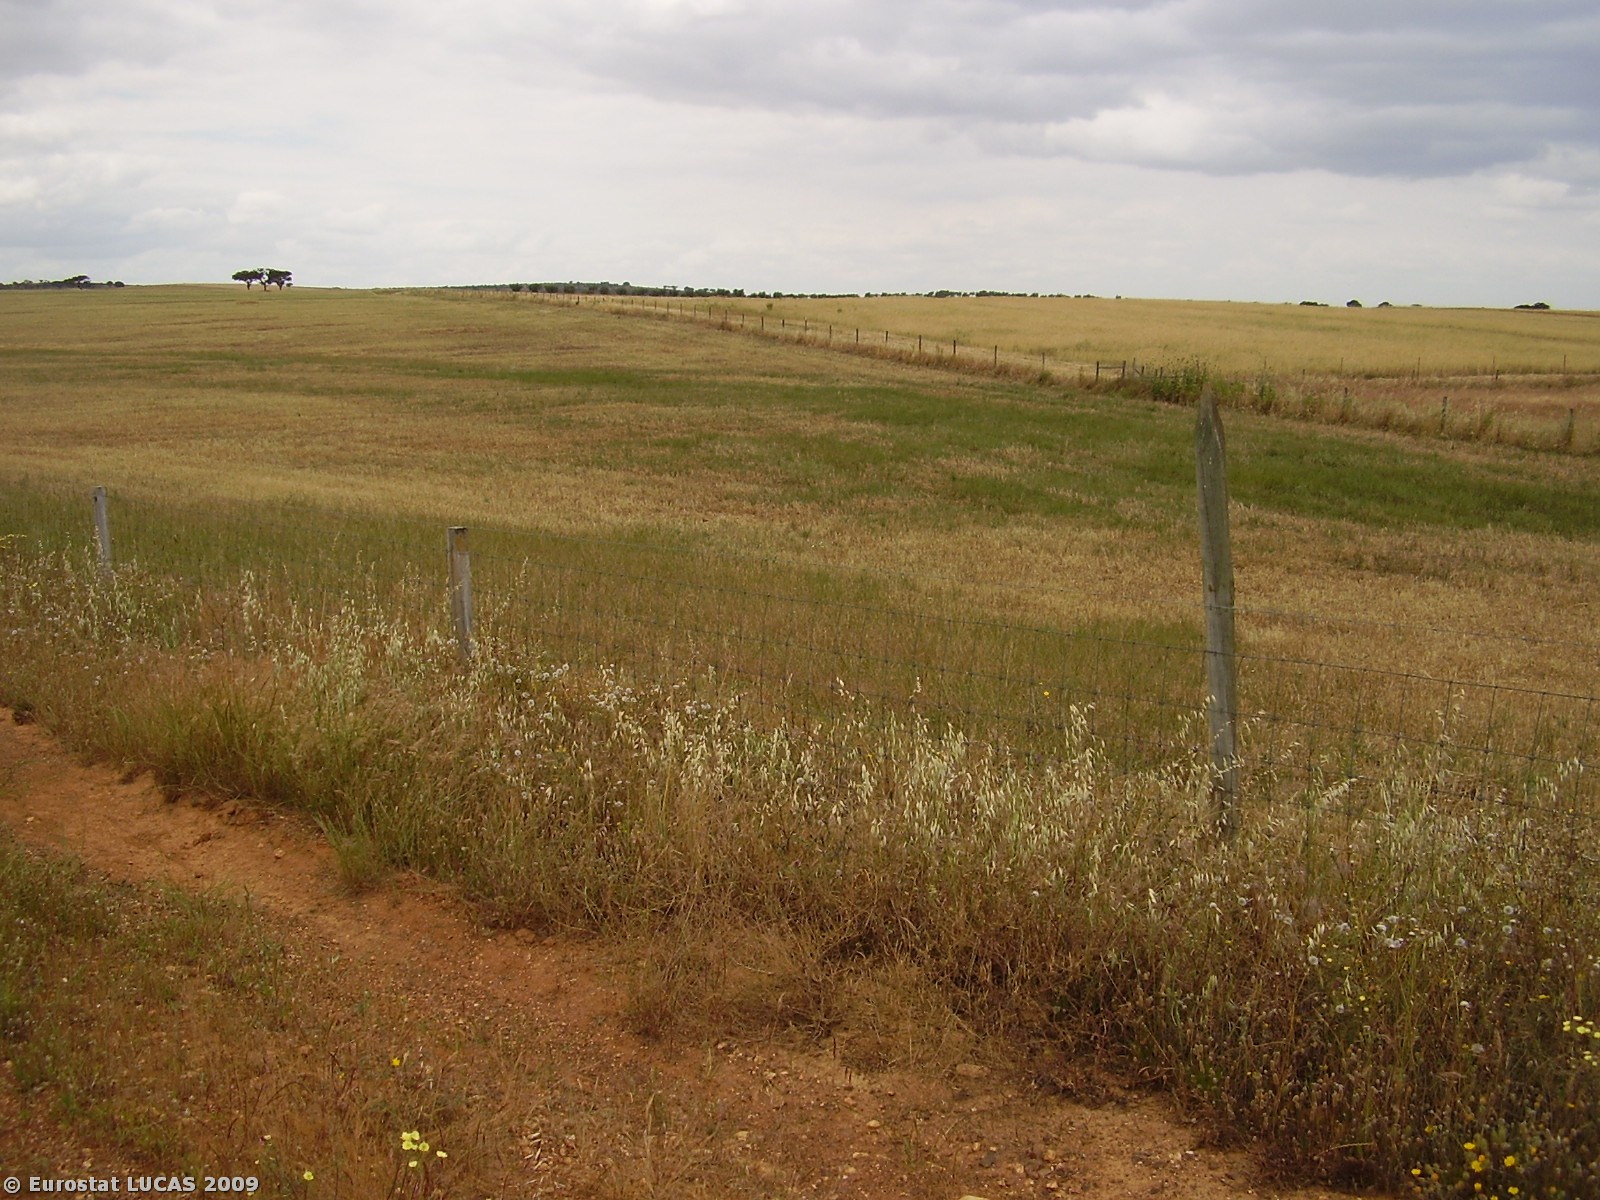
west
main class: Grassland
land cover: Grassland without tree/shrub cover
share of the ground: > 75 %
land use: Agriculture (excluding fallow land and kitchen gardens)
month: May
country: PT
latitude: 37.7596
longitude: -7.8780
